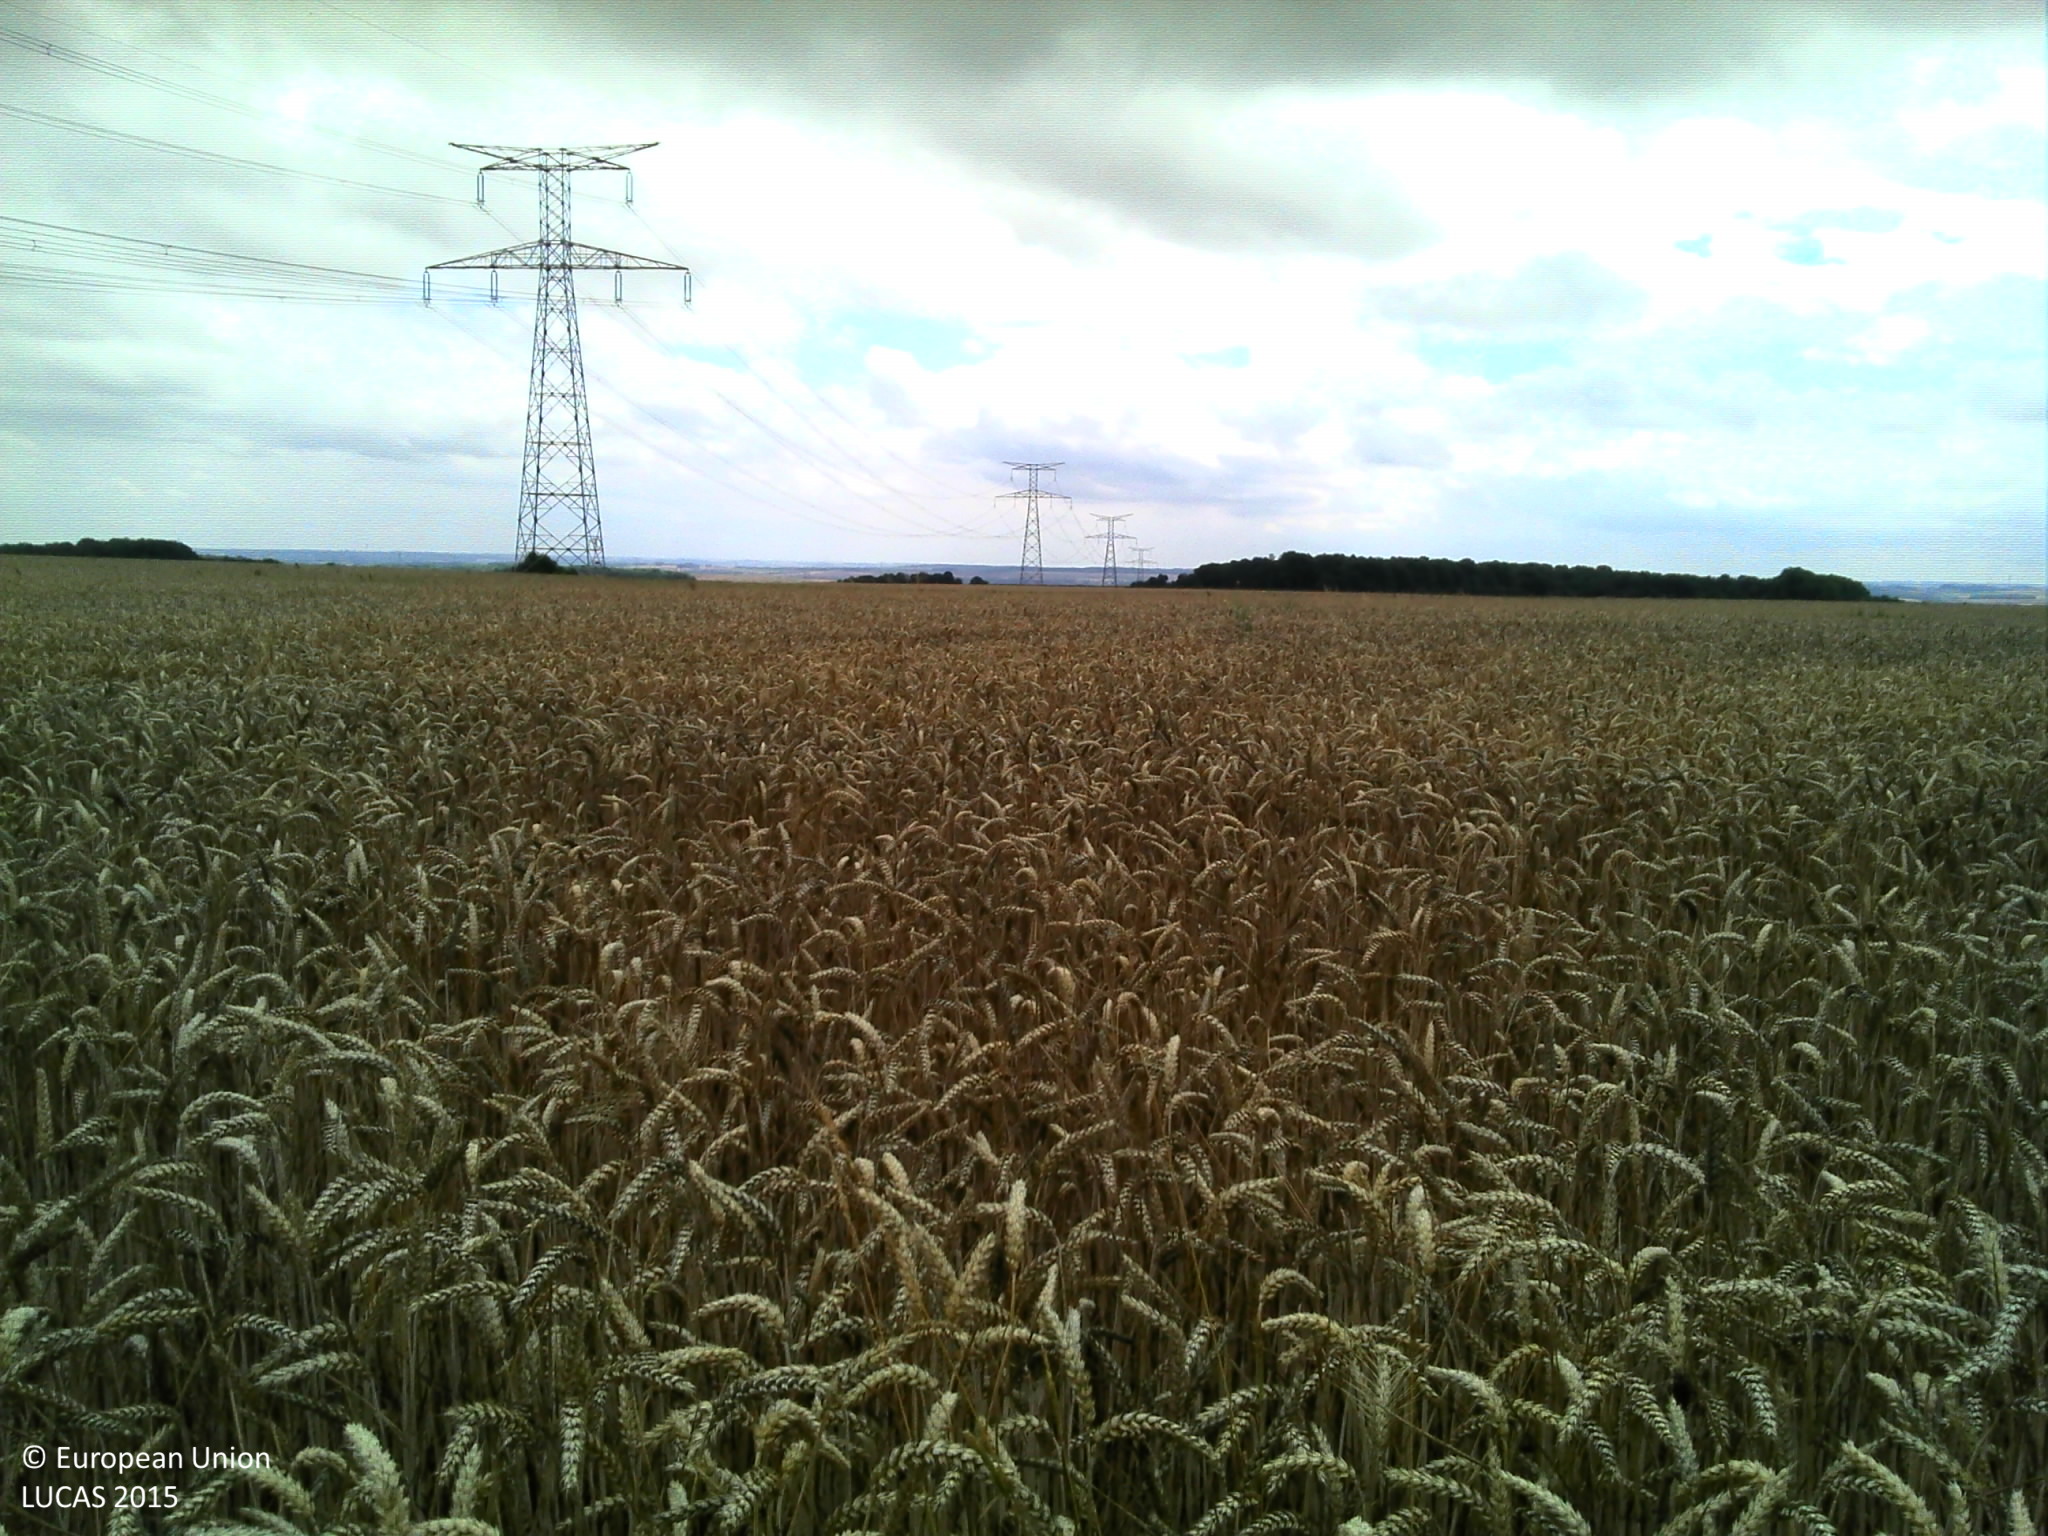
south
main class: Cropland
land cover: Common wheat
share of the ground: > 75 %
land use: Agriculture (excluding fallow land and kitchen gardens)
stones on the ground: < 10 %
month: July
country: FR
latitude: 50.0081
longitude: 2.2138
